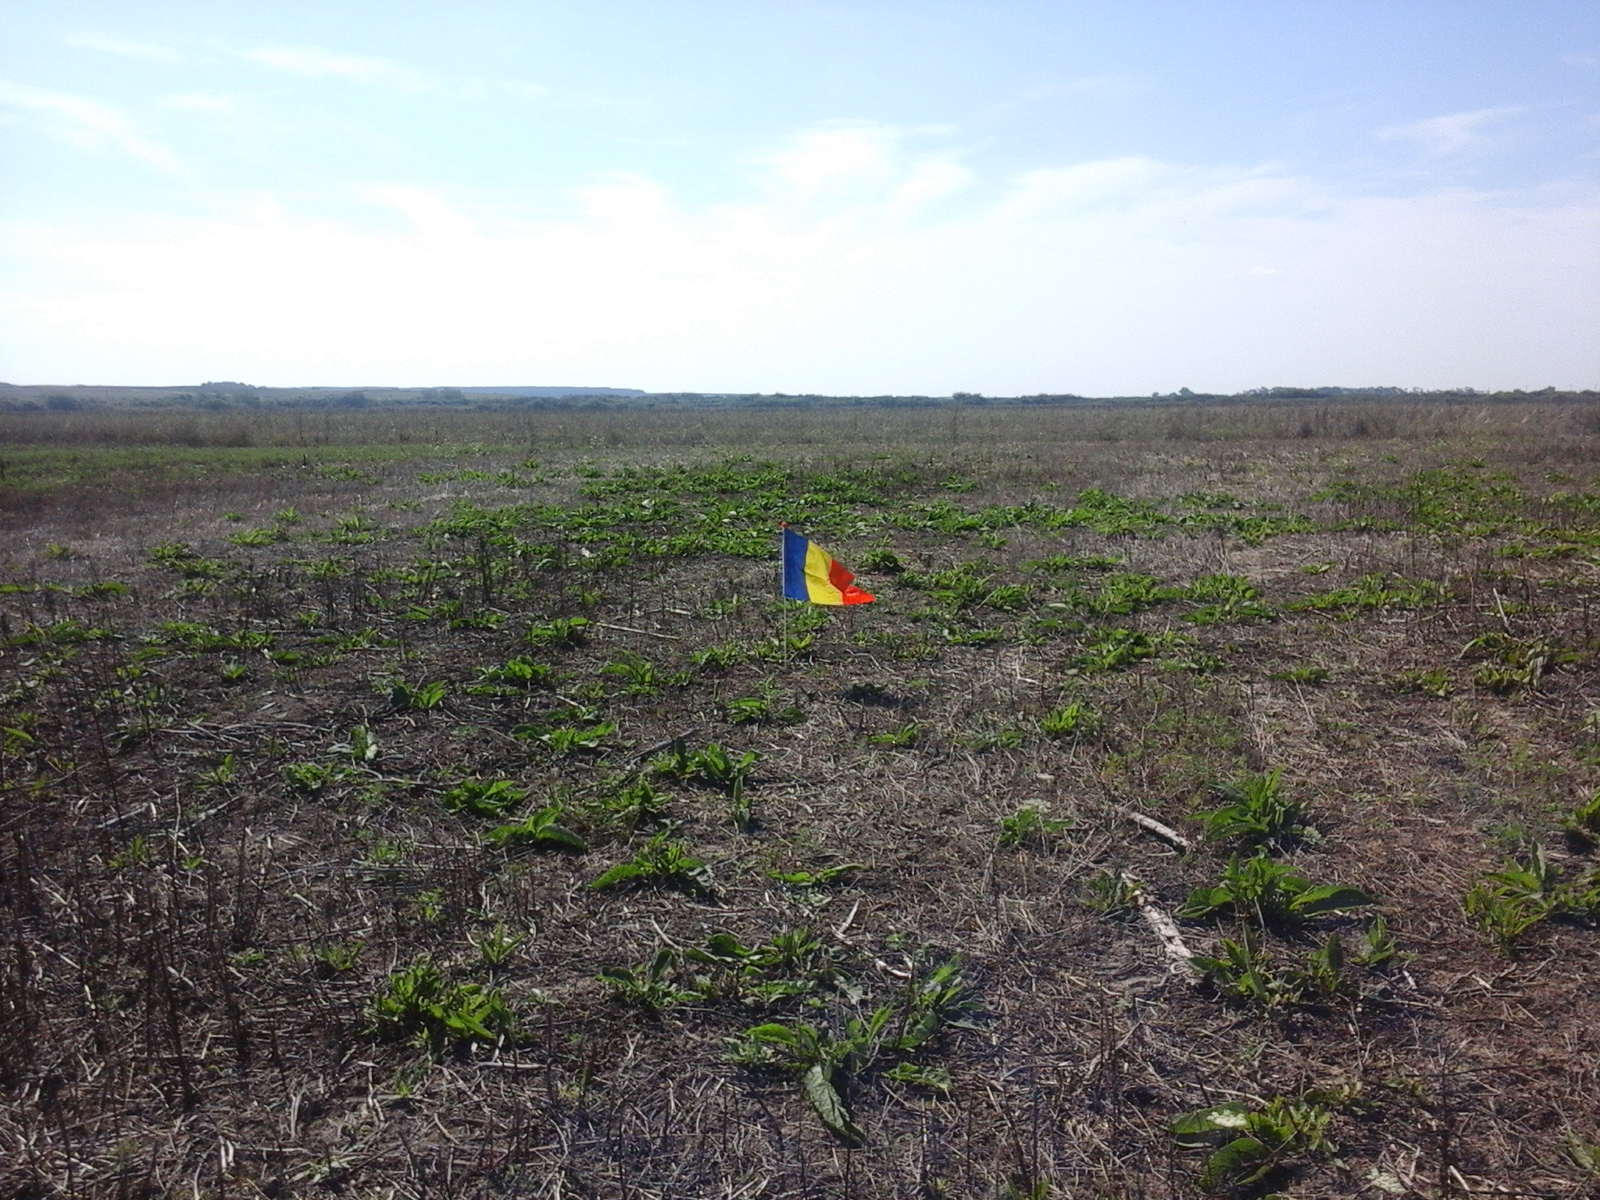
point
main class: Grassland
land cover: Spontaneously vegetated surfaces
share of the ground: > 75 %
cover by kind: herbaceous plants 100 %
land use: Agriculture (excluding fallow land and kitchen gardens)
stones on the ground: < 10 %
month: August
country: RO
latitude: 45.6820
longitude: 21.7586
